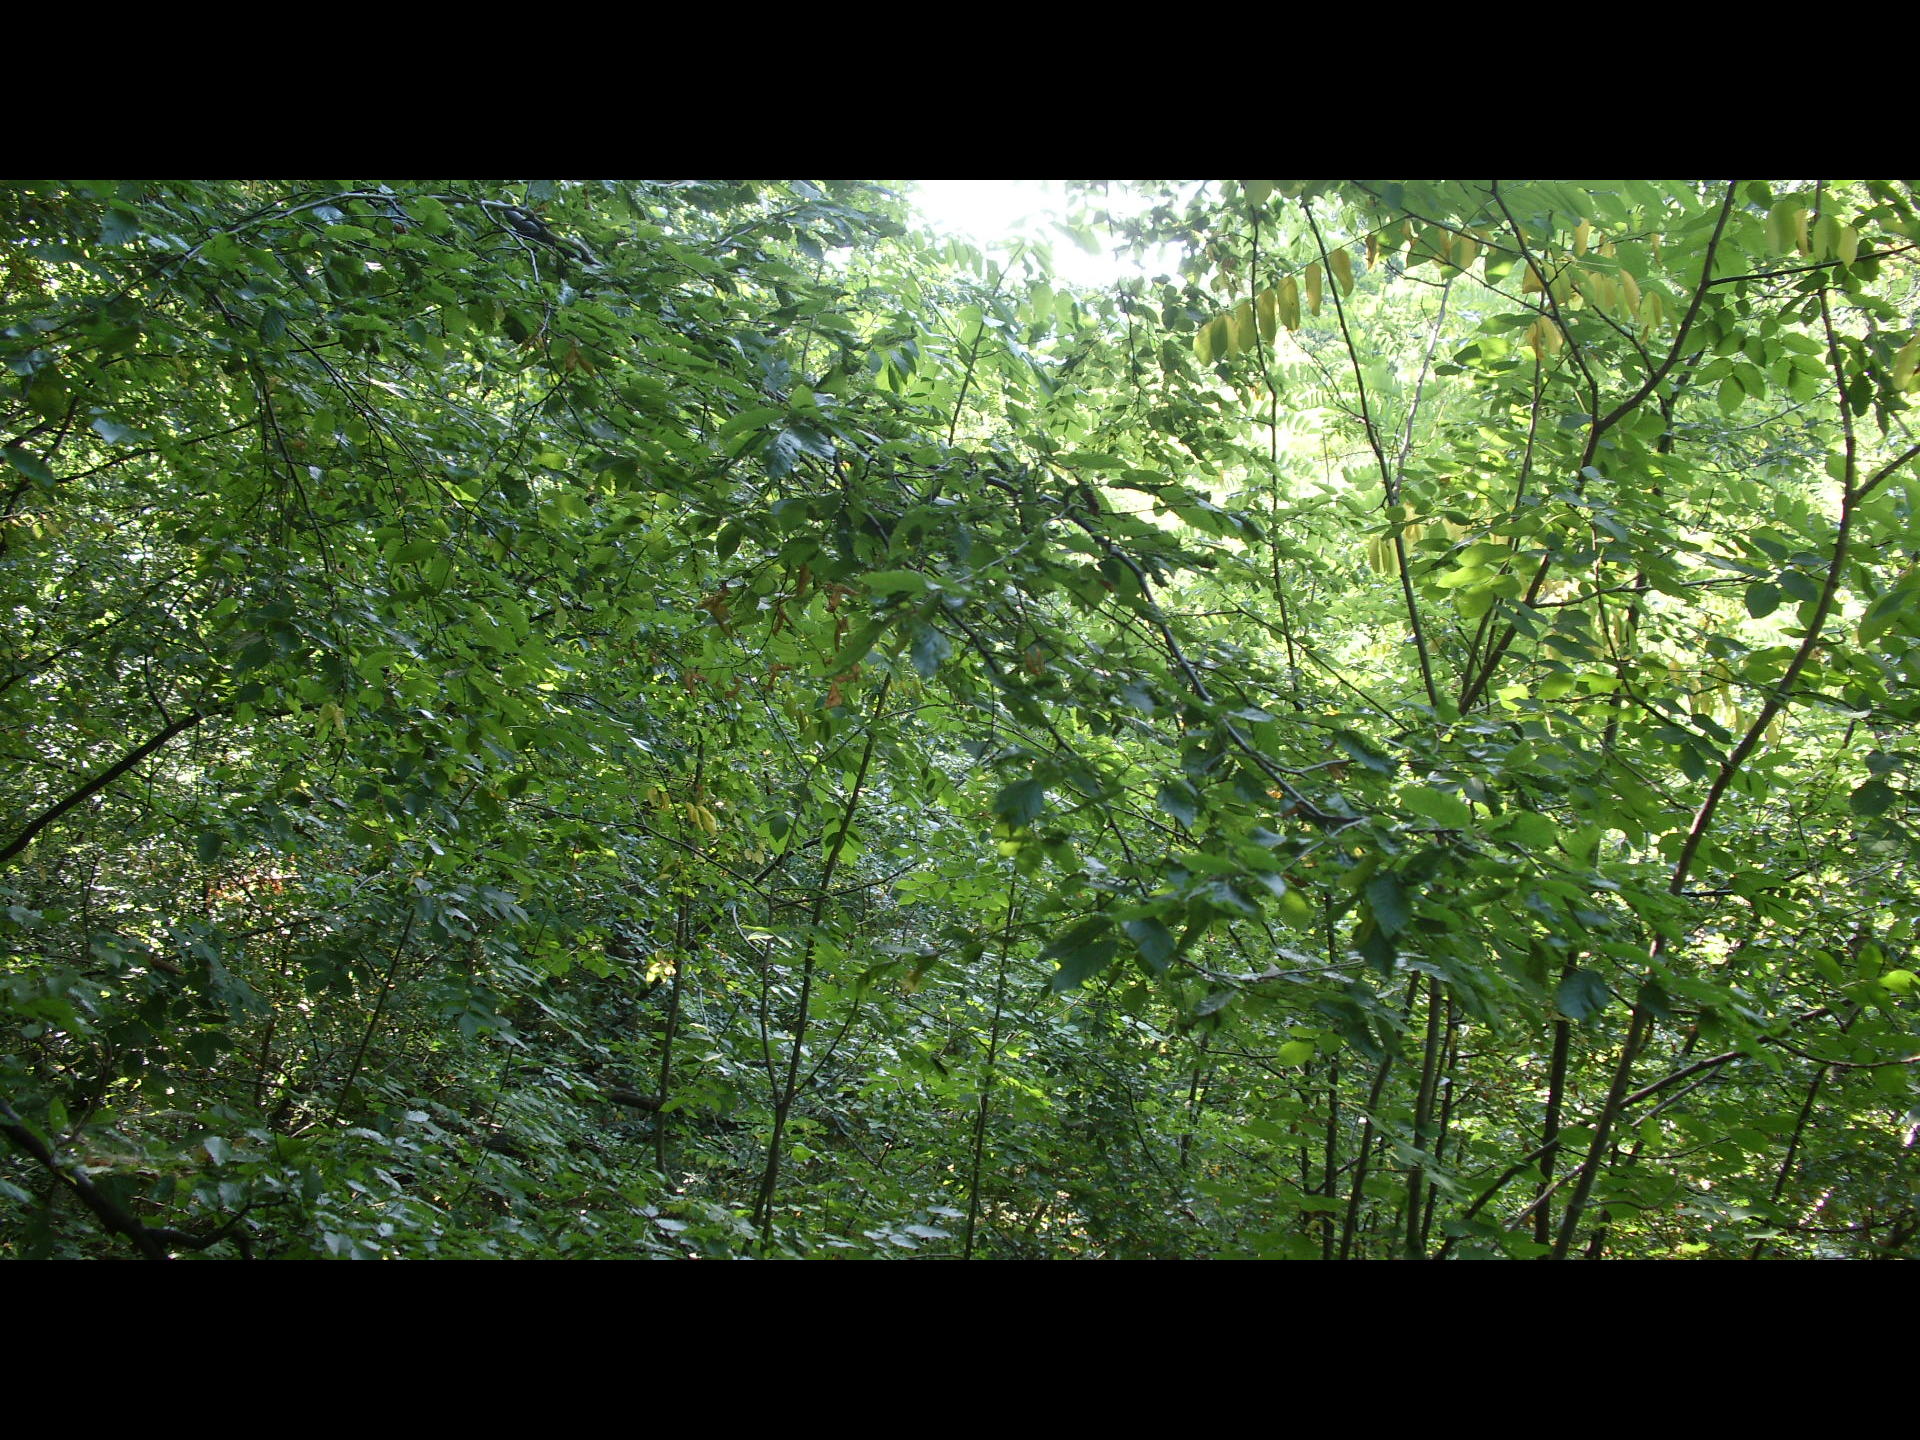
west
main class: Woodland
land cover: Broadleaved woodland
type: mesophytic deciduous forest
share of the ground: > 75 %
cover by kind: broadleaved forest trees 95 %, herbaceous plants 5 %
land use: Forestry
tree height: > 5 m
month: August
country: BG
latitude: 43.3033
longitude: 23.1916
